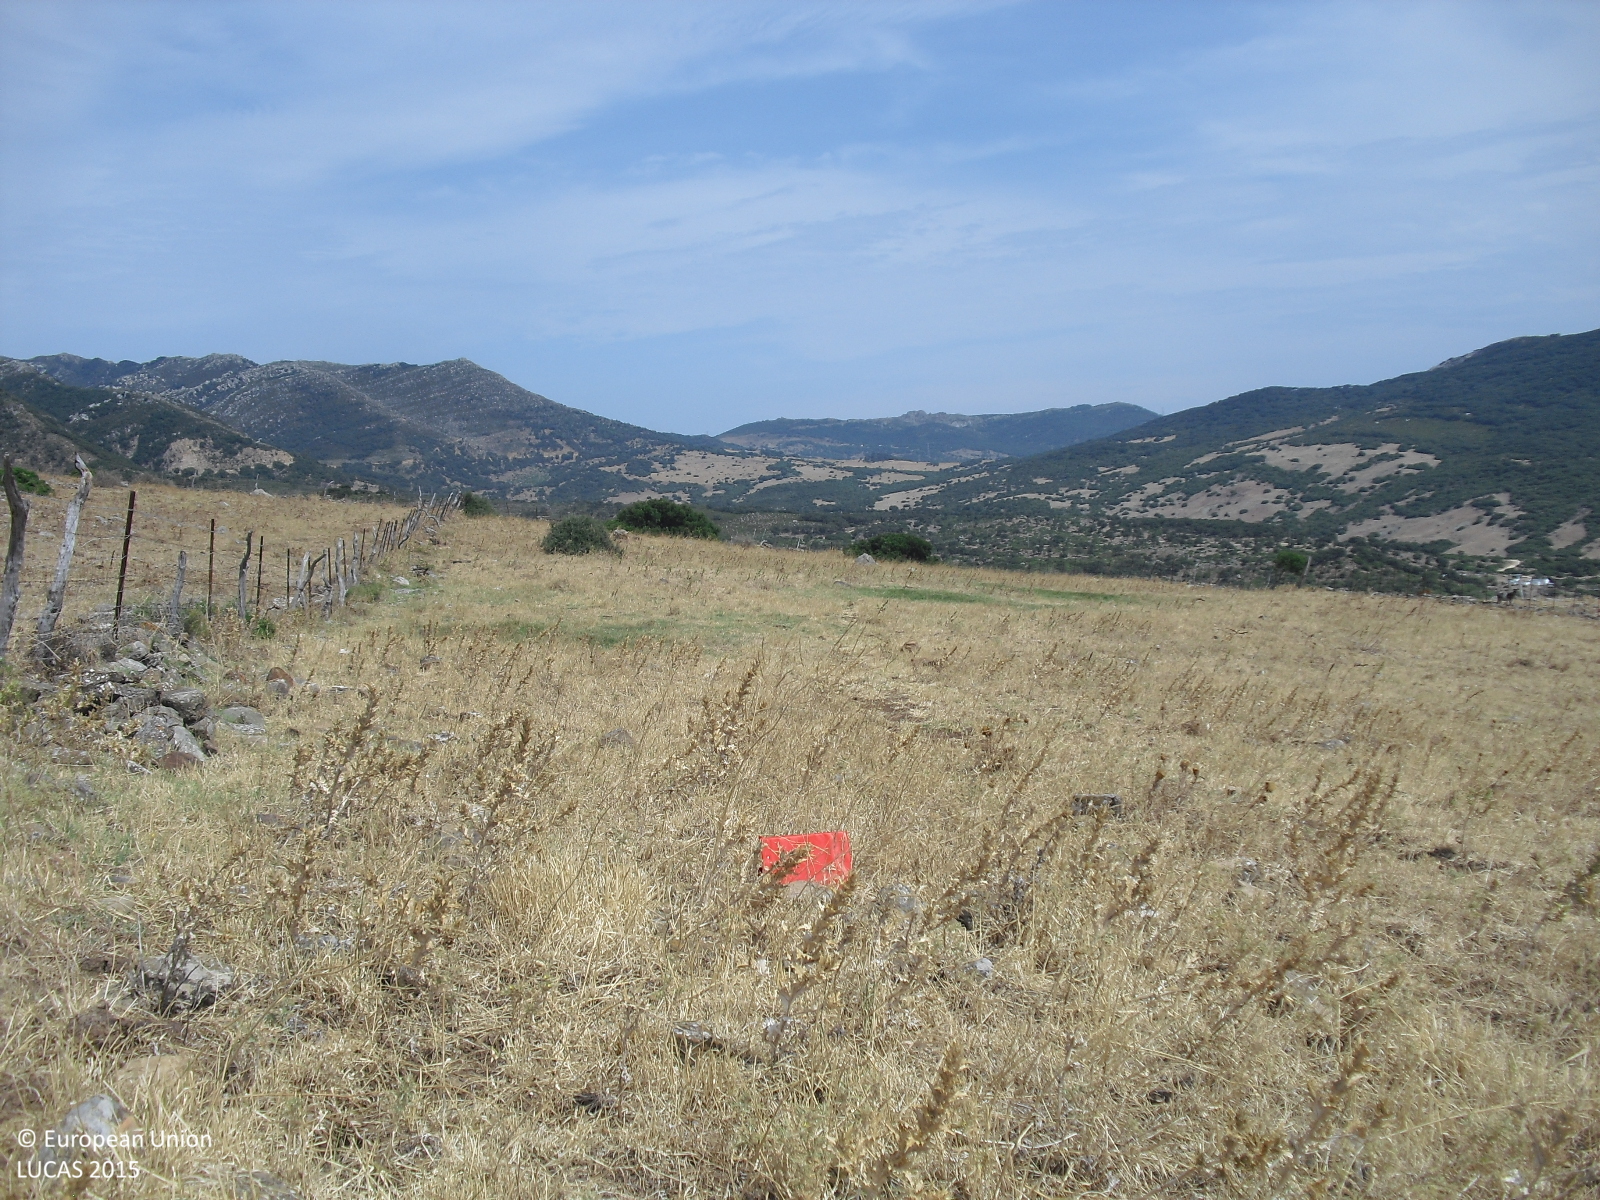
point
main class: Grassland
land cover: Grassland without tree/shrub cover
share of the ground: > 75 %
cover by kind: herbaceous plants 95 %, unconsolidated bare surface 5 %
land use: Agriculture (excluding fallow land and kitchen gardens)
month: July
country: ES
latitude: 36.1014
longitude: -5.5988
